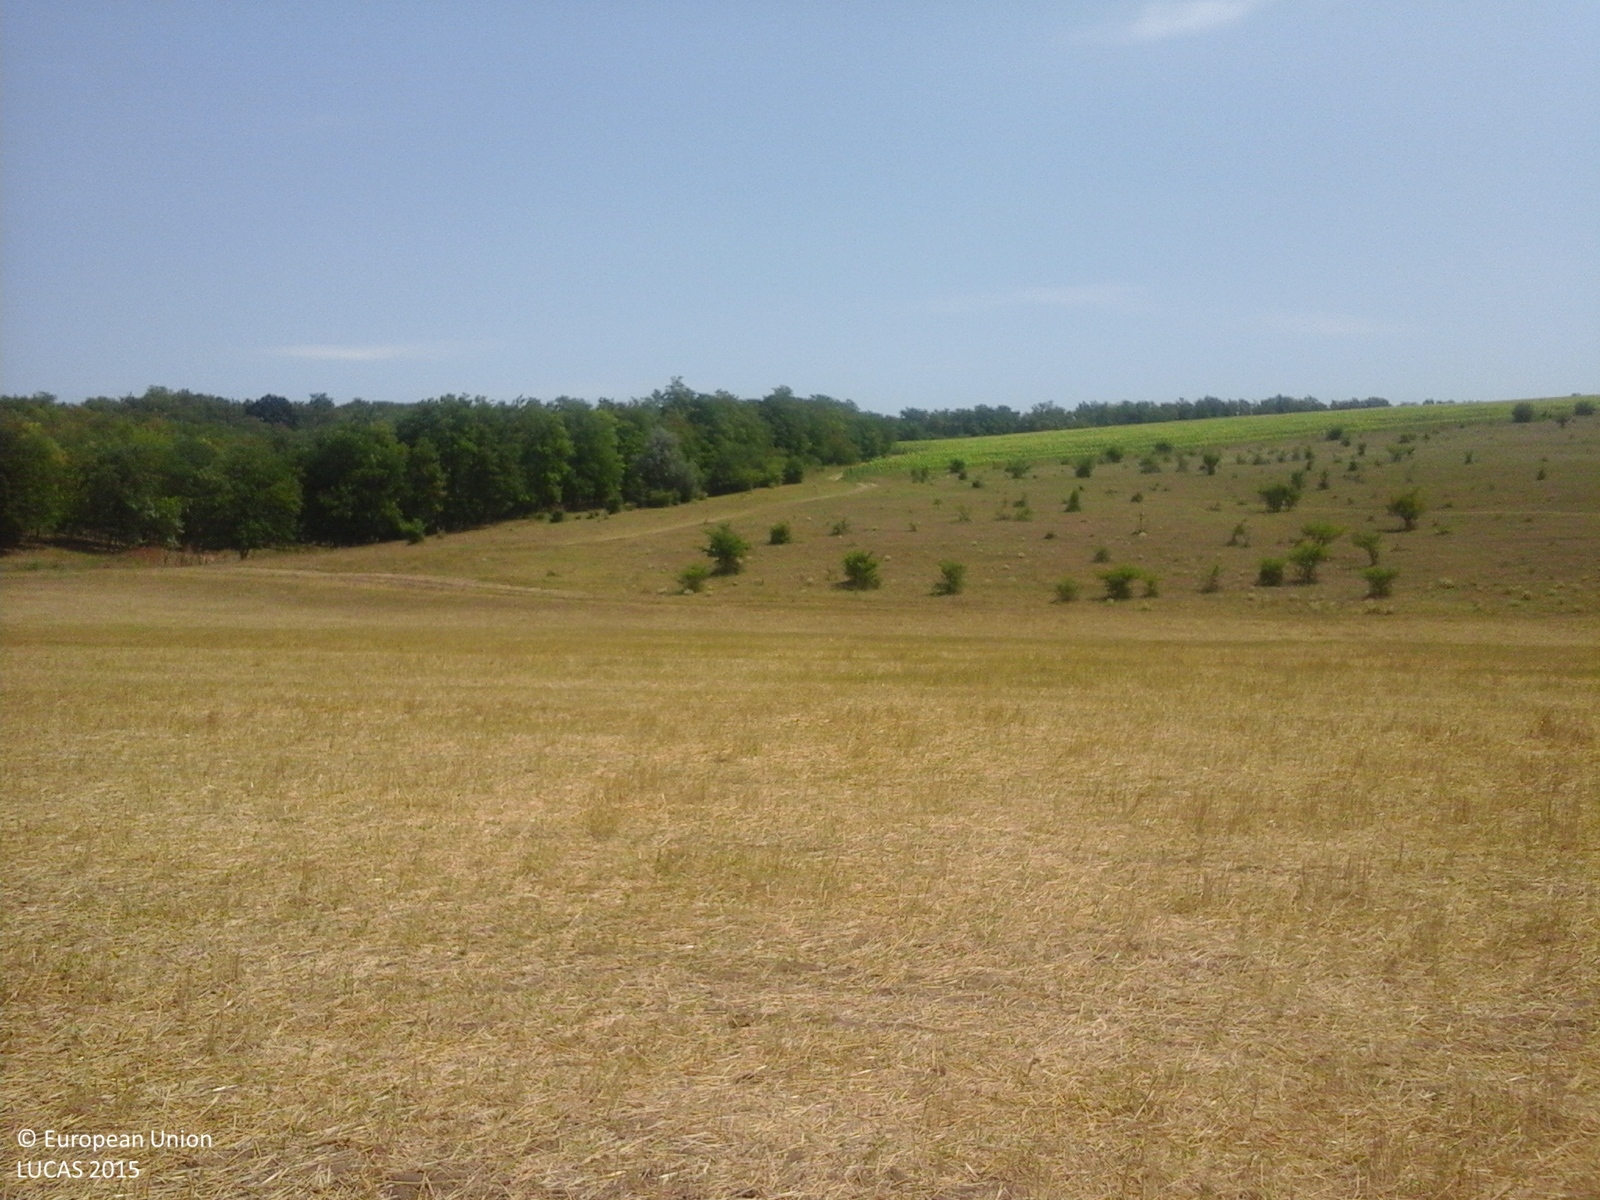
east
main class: Cropland
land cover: Common wheat
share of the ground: 25 - 50 %
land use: Agriculture (excluding fallow land and kitchen gardens)
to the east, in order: Common wheat; Tracks; Grassland without tree/shrub cover; Tracks; Grassland with sparse tree/shrub cover; Broadleaved woodland
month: August
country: RO
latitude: 44.0312
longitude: 27.8019
